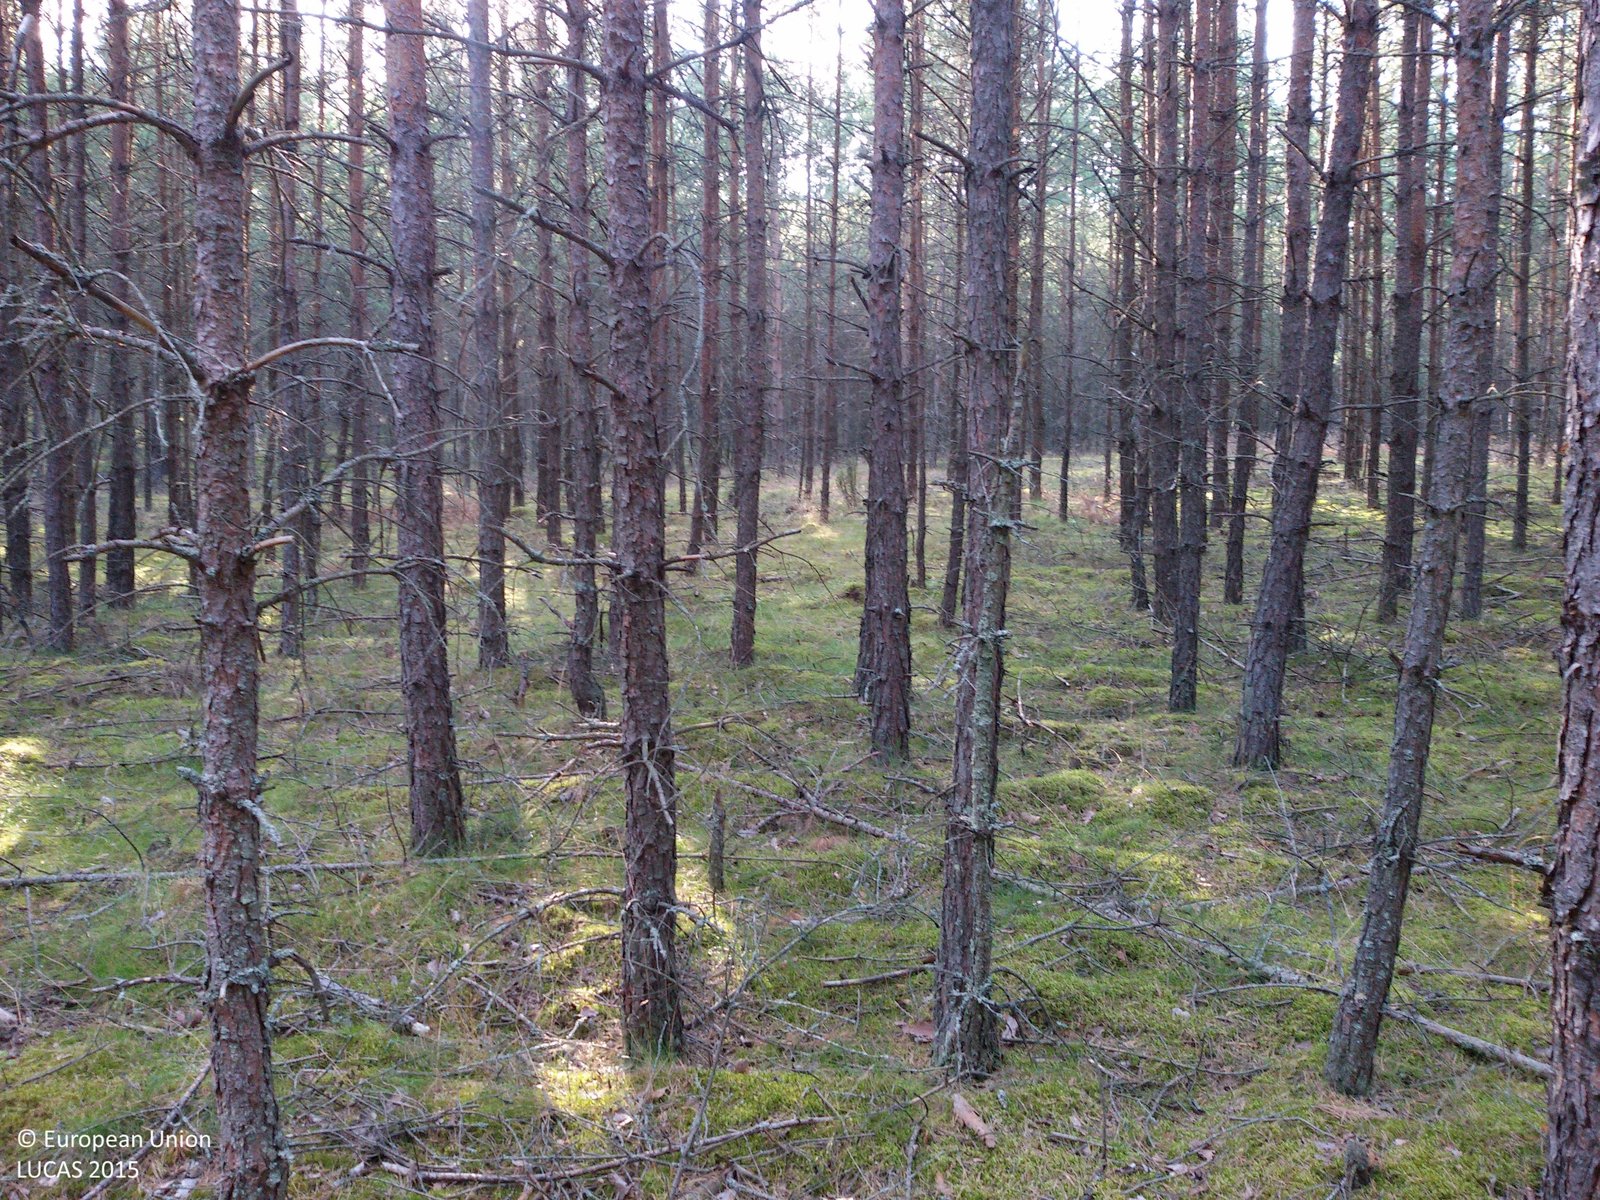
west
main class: Woodland
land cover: Pine dominated coniferous woodland
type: hemiboreal forest and nemoral coniferous forest and mixed broadleaved-coniferous forest
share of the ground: > 75 %
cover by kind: coniferous forest trees 85 %, lichens and mosses 10 %, herbaceous plants 5 %
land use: Forestry
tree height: > 5 m
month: August
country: PL
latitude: 54.1593
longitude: 17.8385
